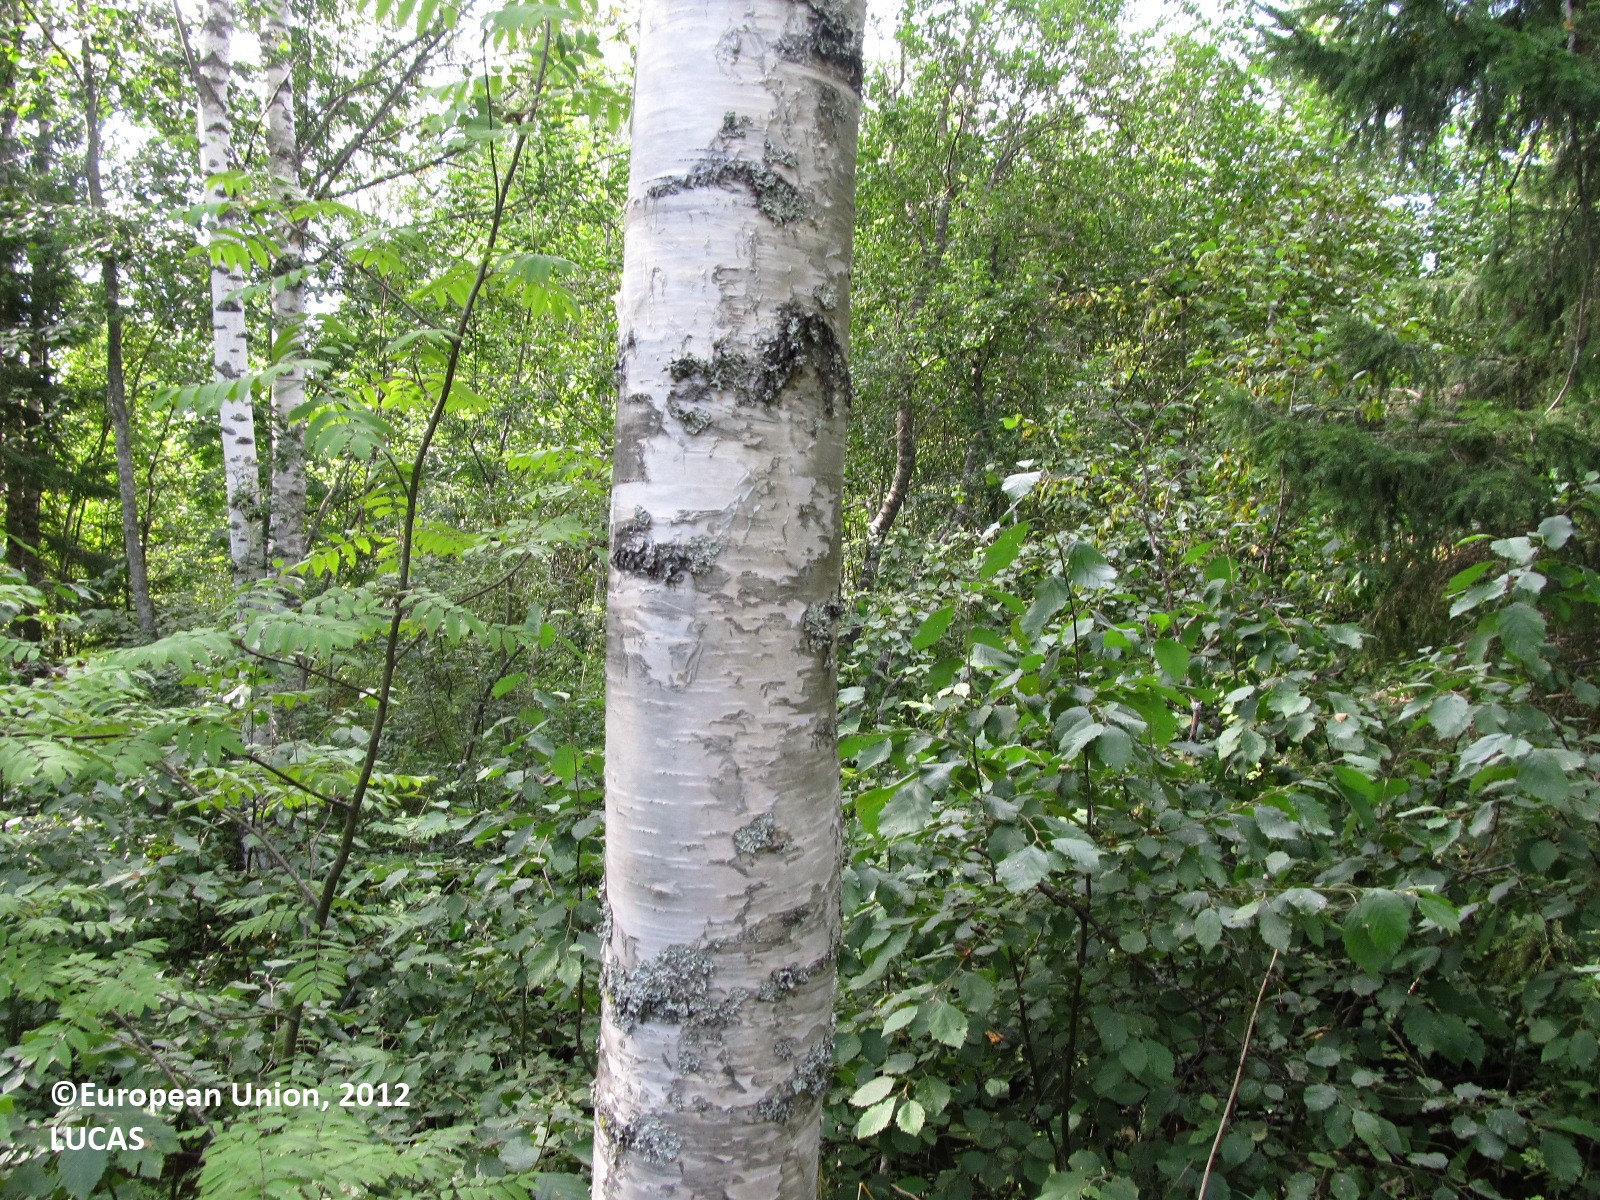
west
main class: Woodland
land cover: Broadleaved woodland
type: boreal forest
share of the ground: 50 - 75 %
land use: Forestry
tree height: > 5 m
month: August
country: FI
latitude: 62.4797
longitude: 27.6913
